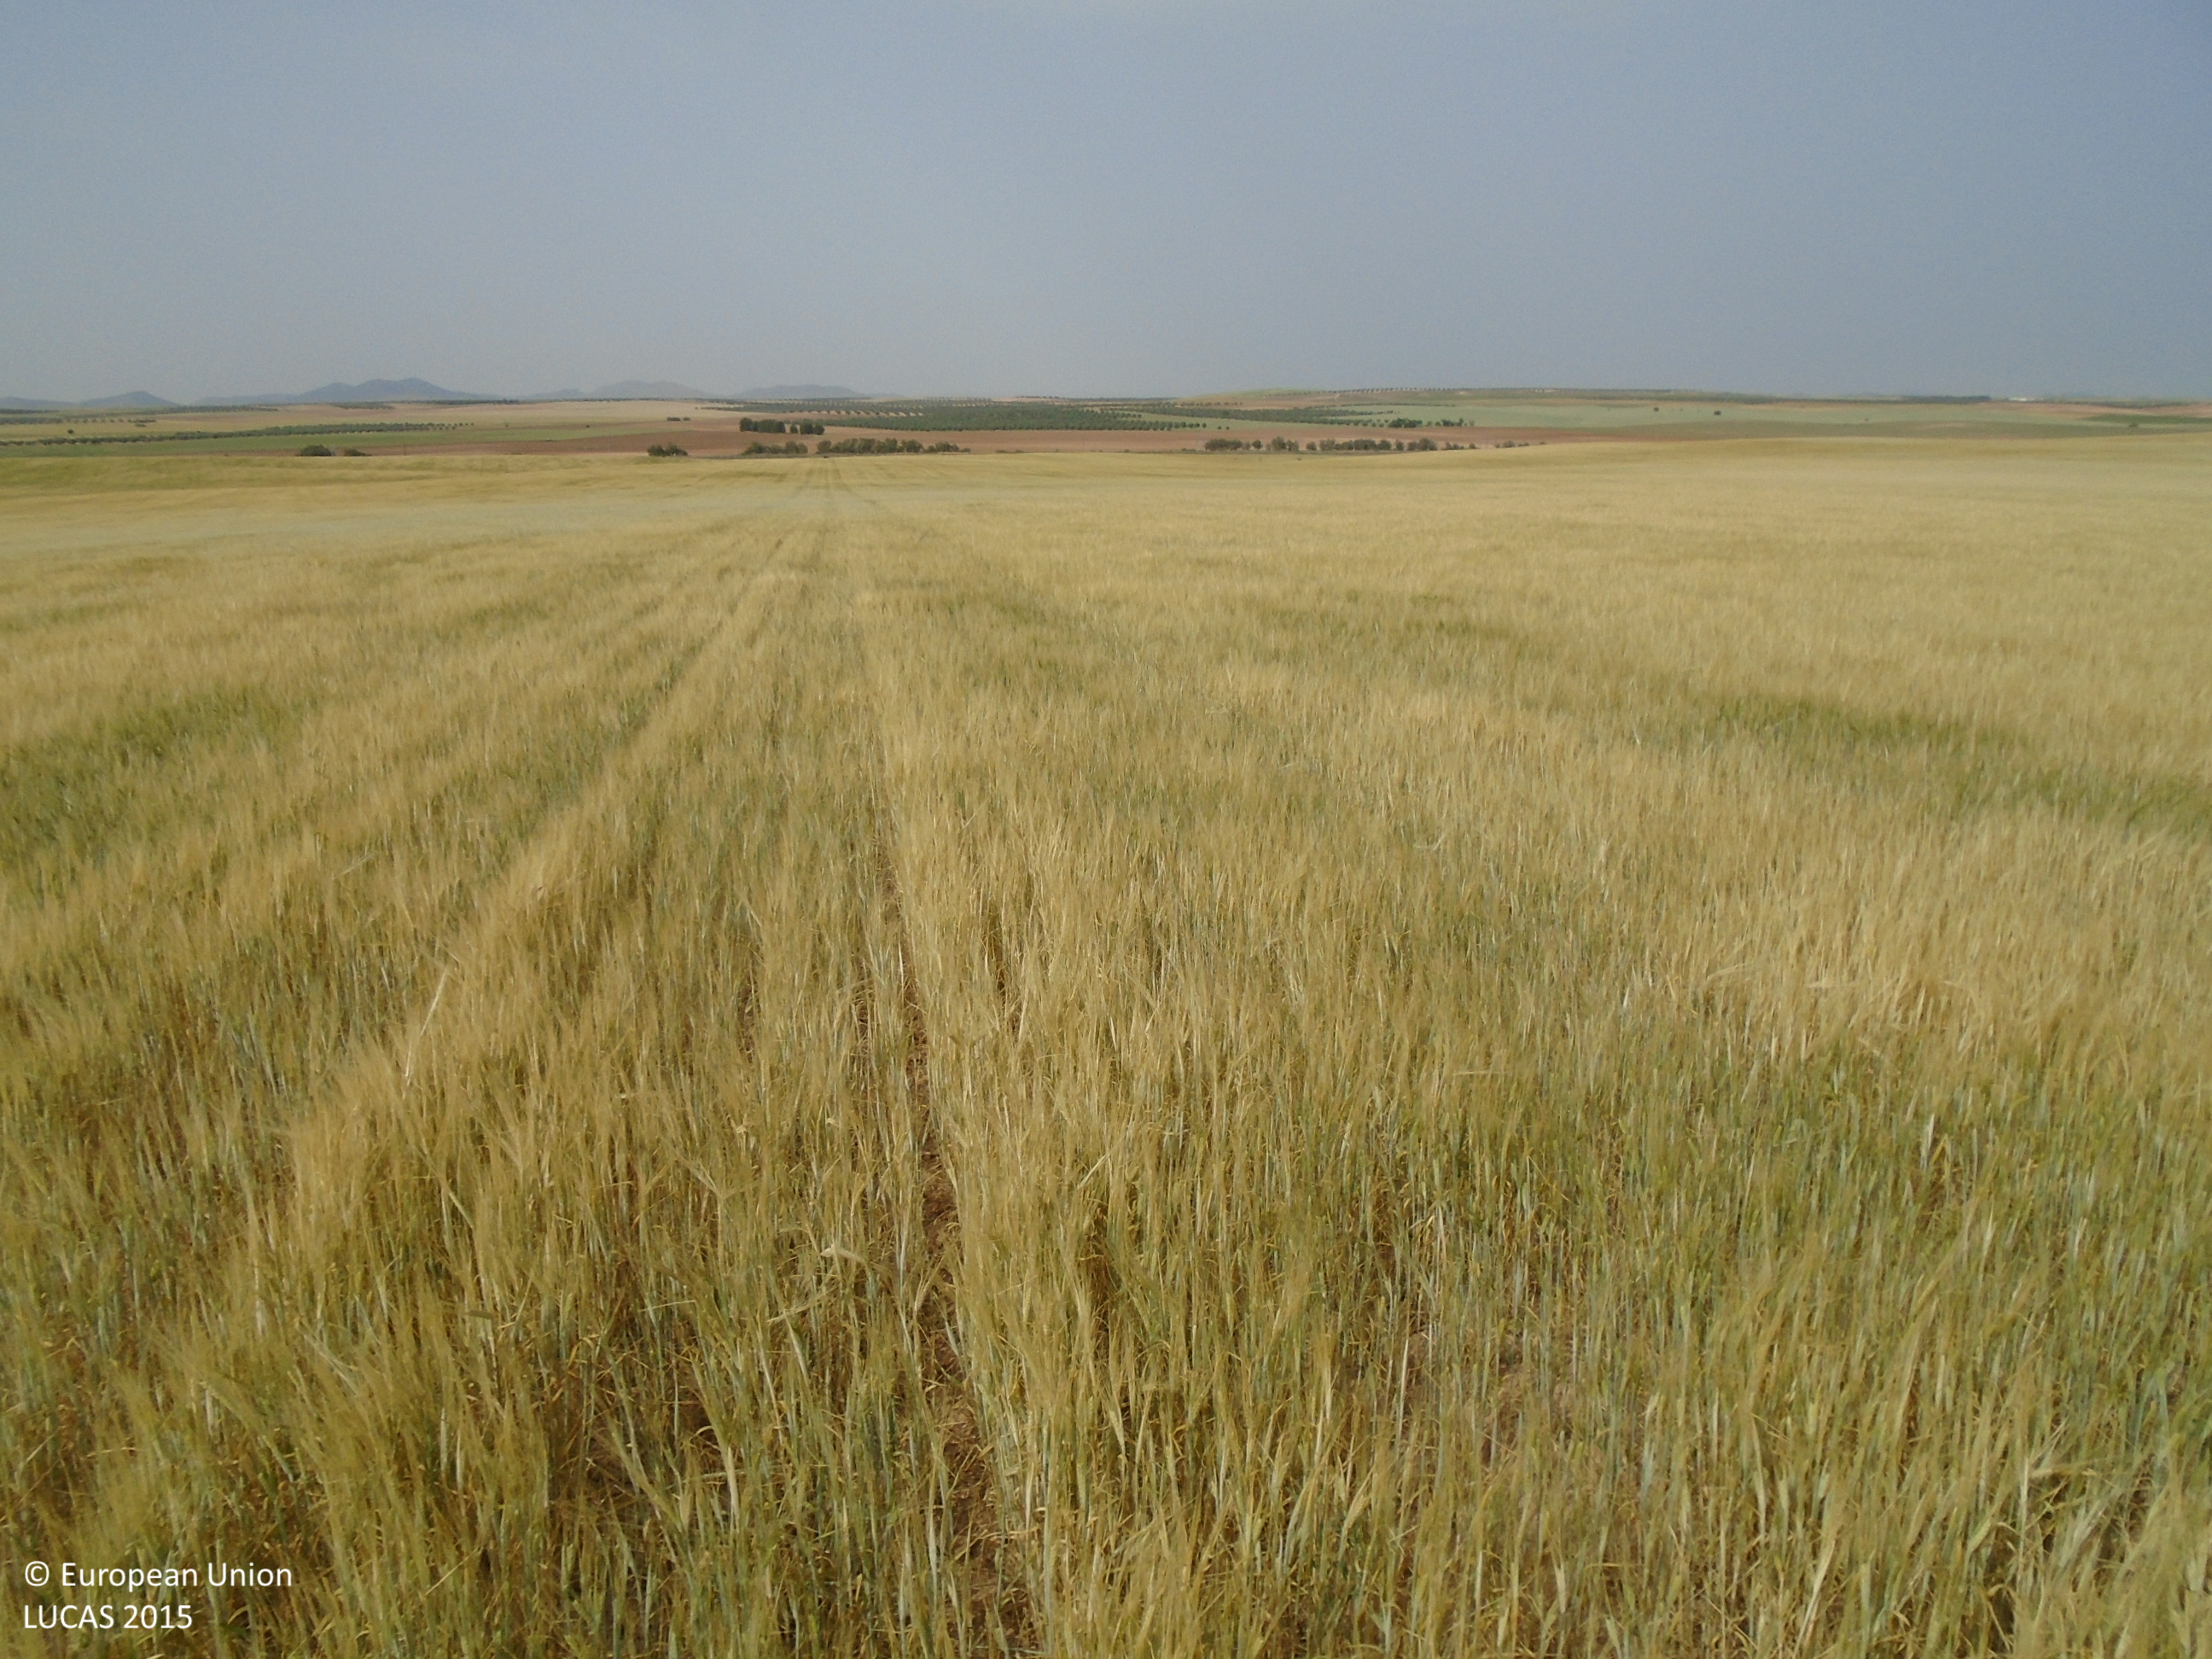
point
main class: Cropland
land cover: Barley
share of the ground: > 75 %
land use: Agriculture (excluding fallow land and kitchen gardens)
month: May
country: ES
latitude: 39.7905
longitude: -3.6091
